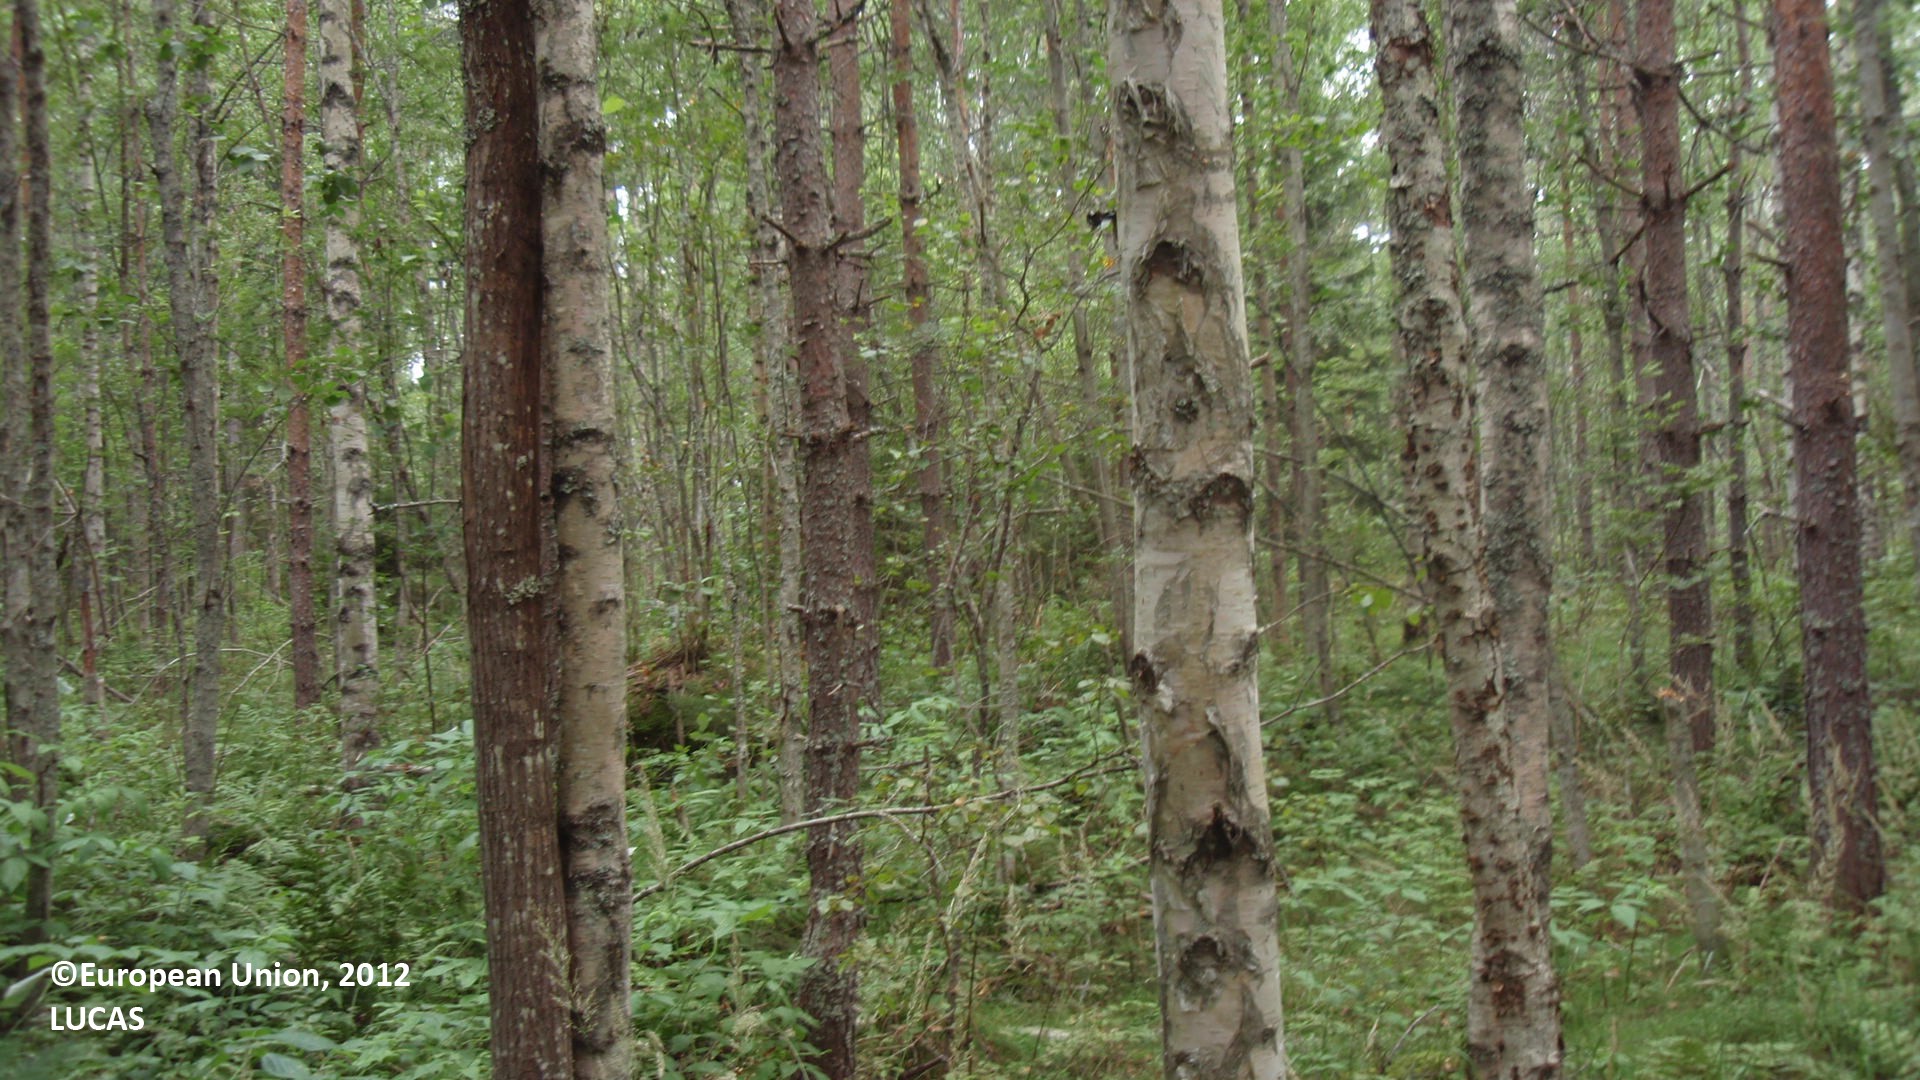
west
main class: Woodland
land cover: Pine dominated mixed woodland
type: boreal forest
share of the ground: > 75 %
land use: Forestry
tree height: > 5 m
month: August
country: FI
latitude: 61.0890
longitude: 27.6729
